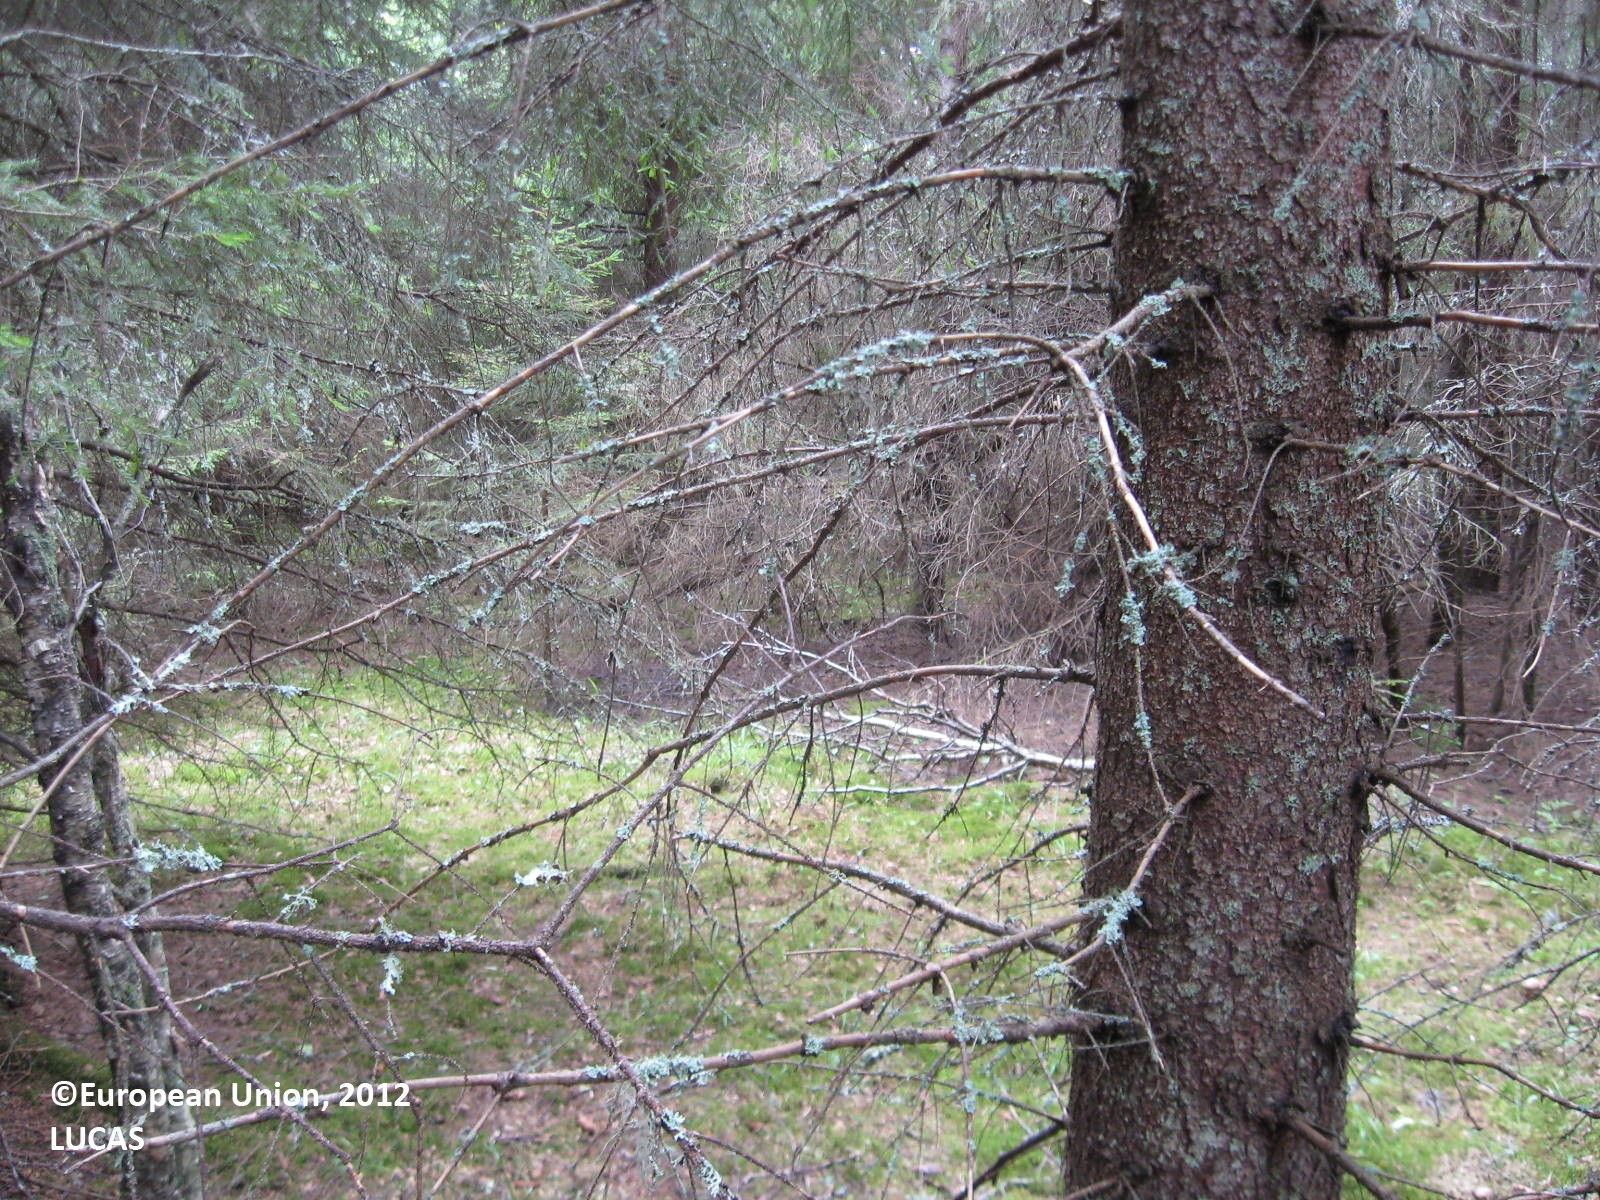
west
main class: Woodland
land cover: Spruce dominated coniferous woodland
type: boreal forest
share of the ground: > 75 %
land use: Forestry
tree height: > 5 m
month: July
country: FI
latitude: 62.0335
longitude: 21.3805
